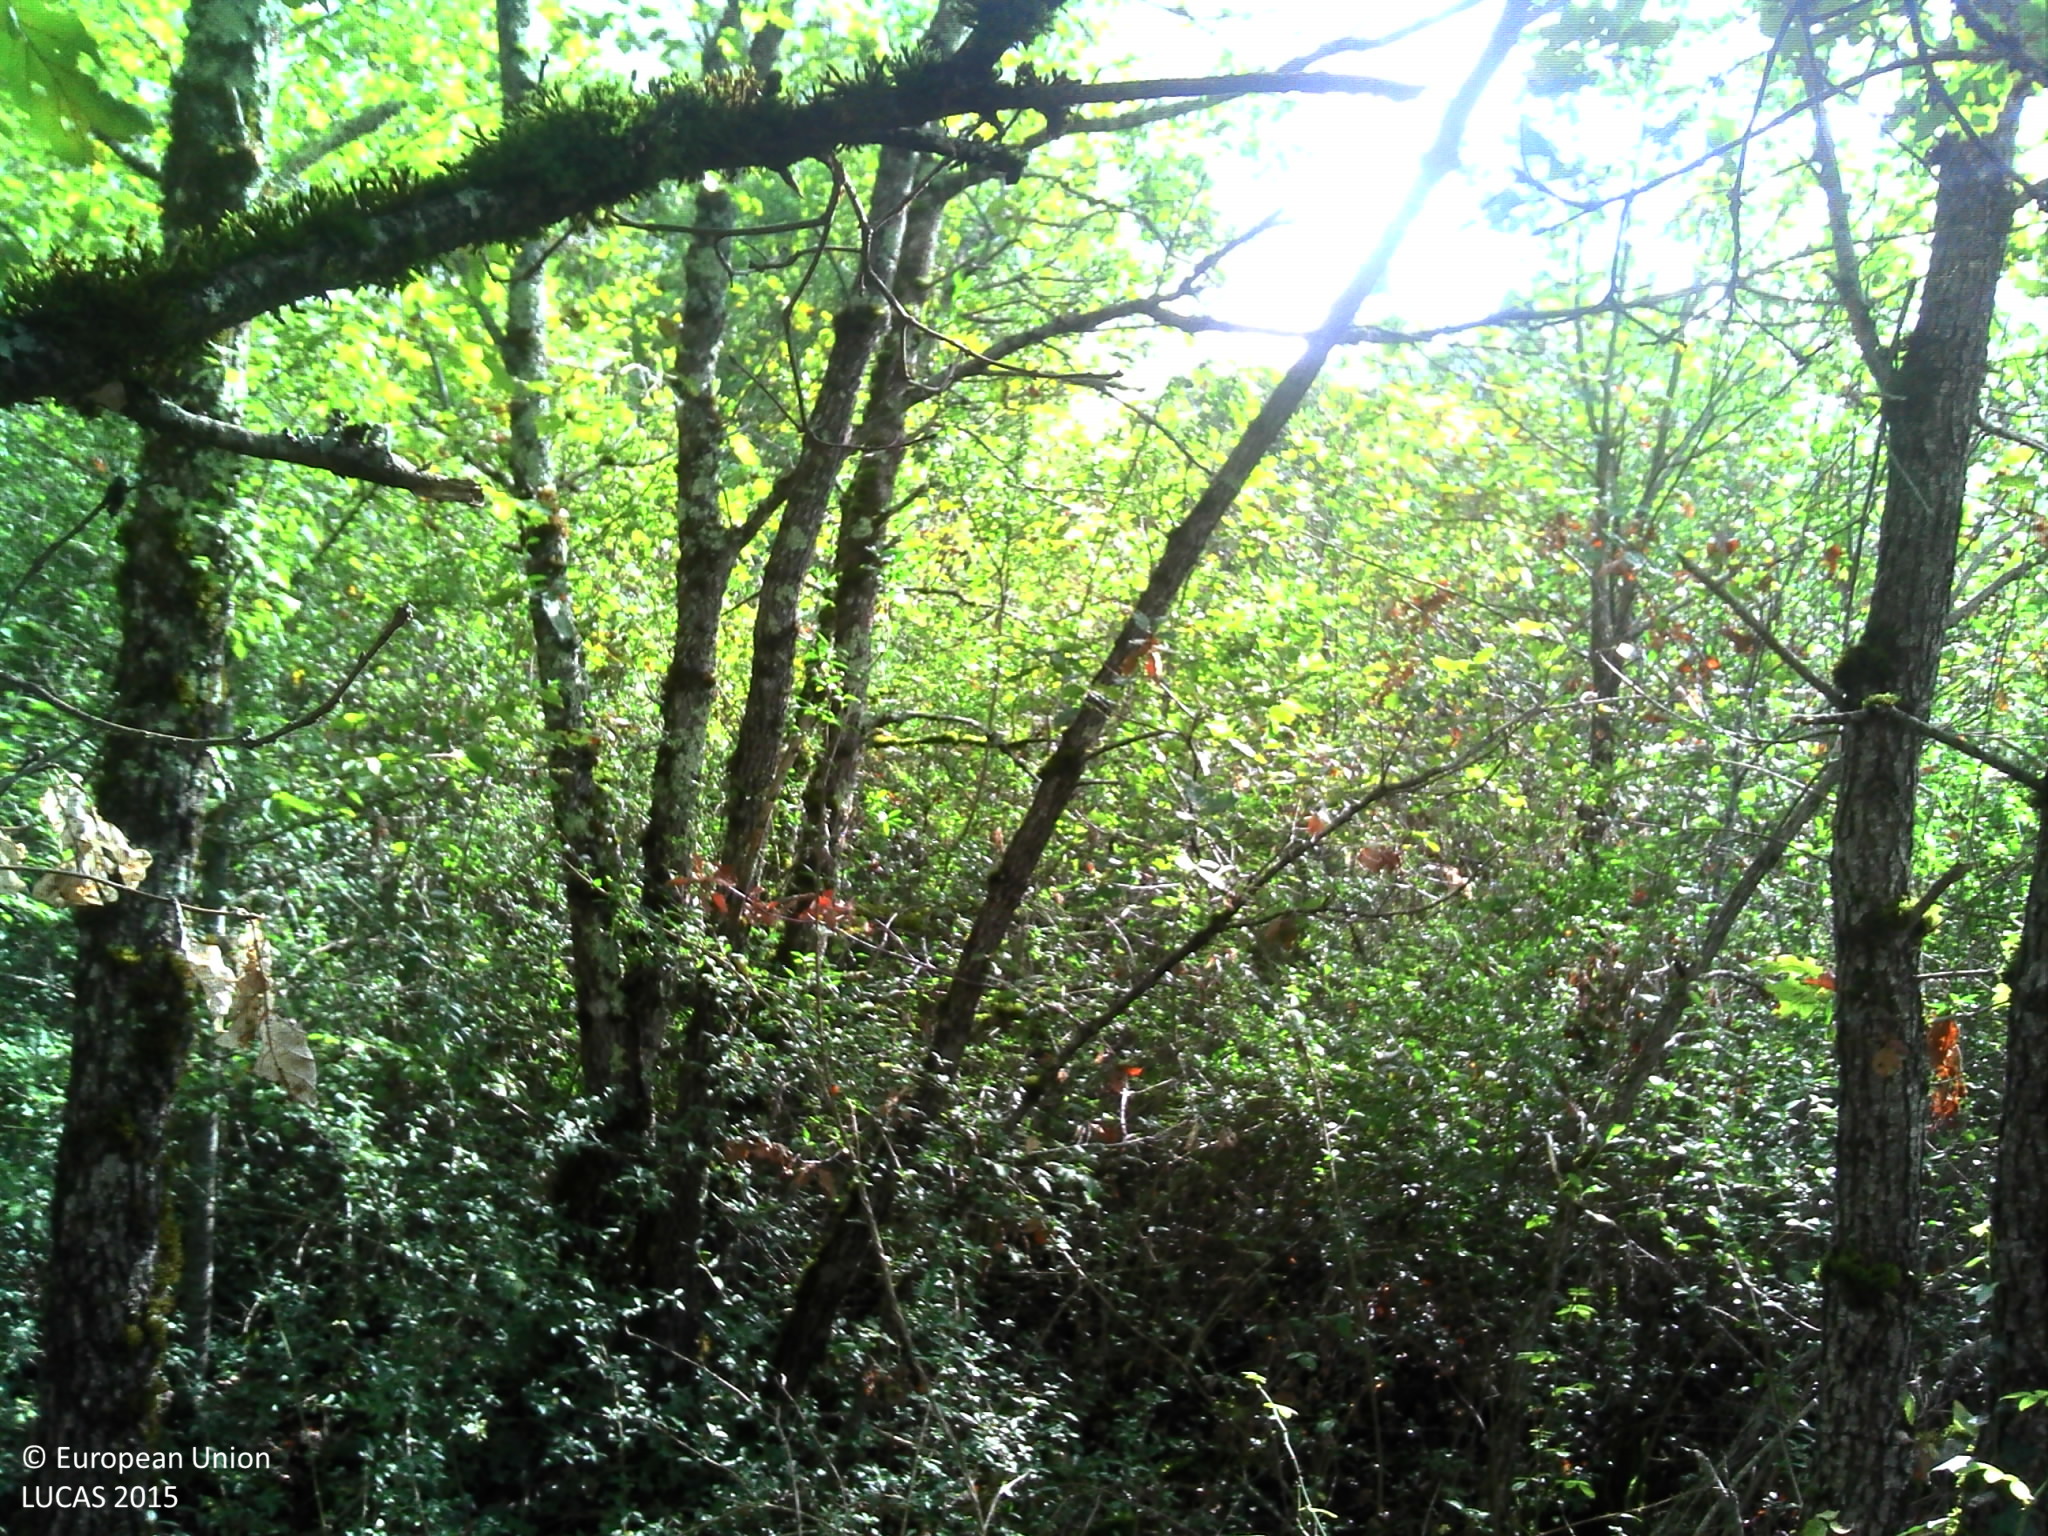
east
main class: Woodland
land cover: Broadleaved woodland
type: mesophytic deciduous forest
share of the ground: > 75 %
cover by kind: broadleaved forest trees 85 %, lichens and mosses 10 %, herbaceous plants 5 %
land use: Forestry
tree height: > 5 m
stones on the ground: < 10 %
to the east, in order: Broadleaved woodland; Fences; Dry stone walls; Grassland with sparse tree/shrub cover; Fences; Dry stone walls; Broadleaved woodland; Dry stone walls; Broadleaved woodland
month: September
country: FR
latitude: 44.8935
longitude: 1.5508
